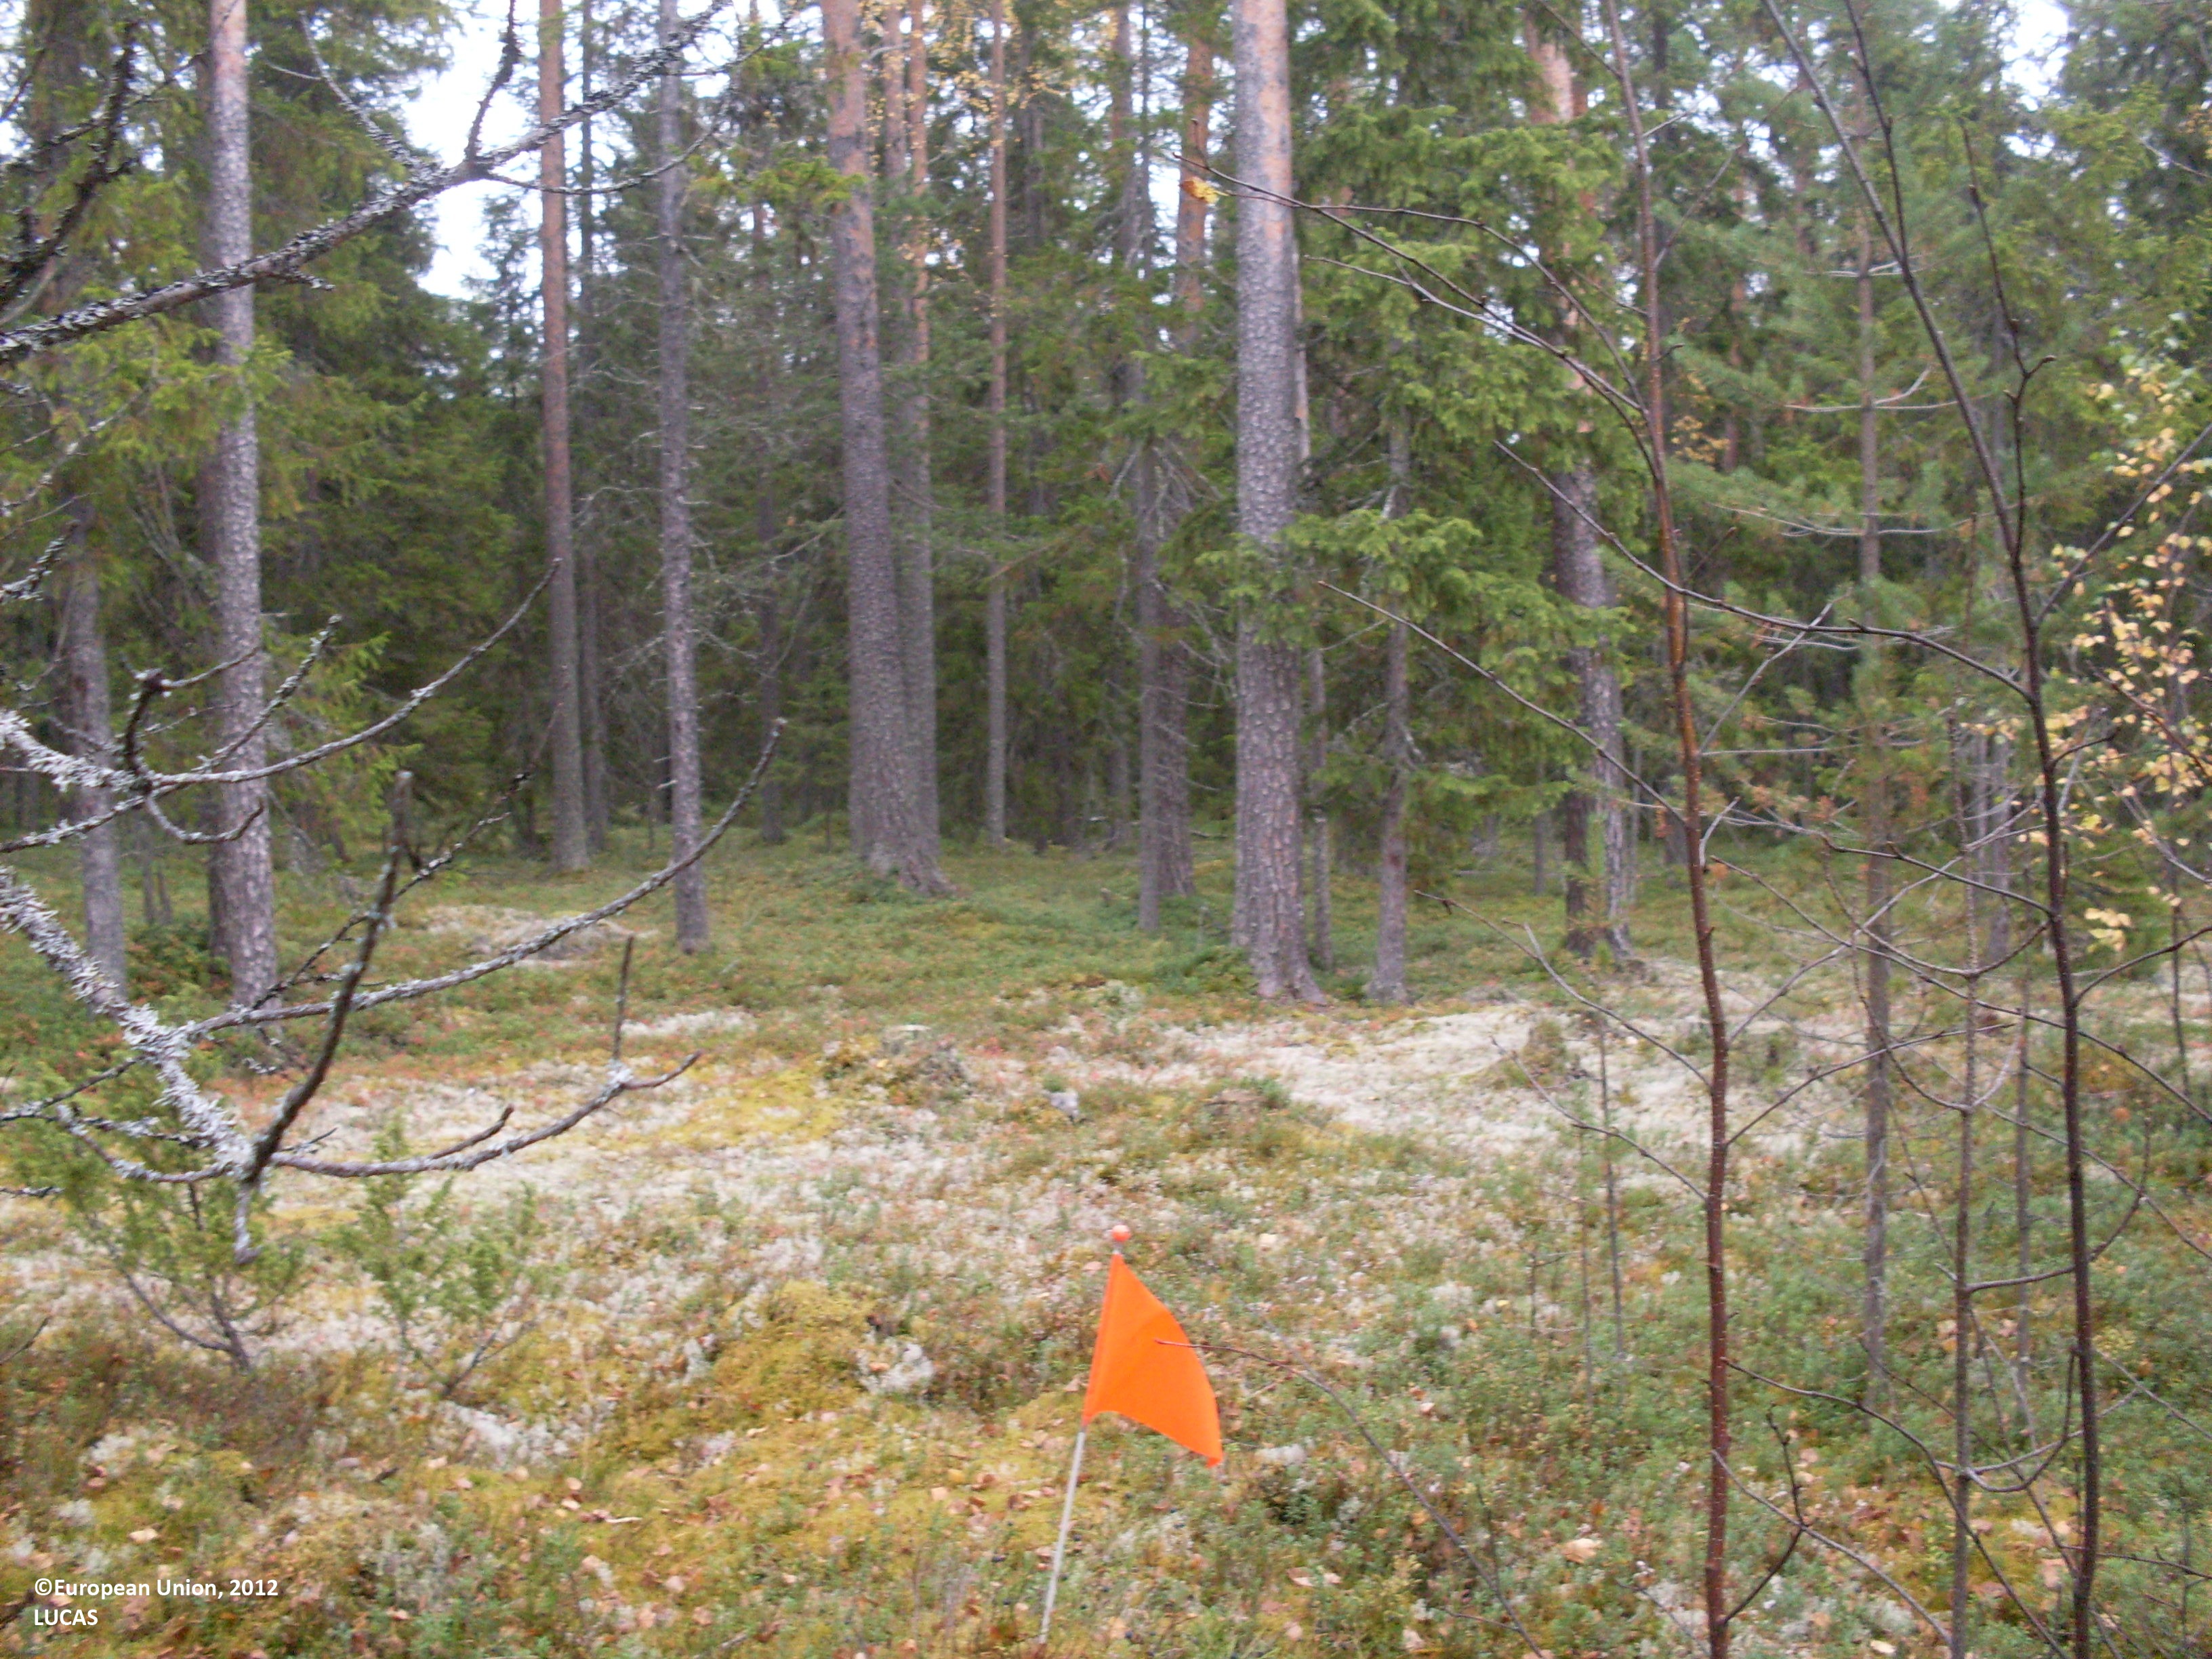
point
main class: Woodland
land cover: Pine dominated mixed woodland
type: boreal forest
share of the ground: 50 - 75 %
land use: Forestry
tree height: > 5 m
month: September
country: FI
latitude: 64.6402
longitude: 28.9611
